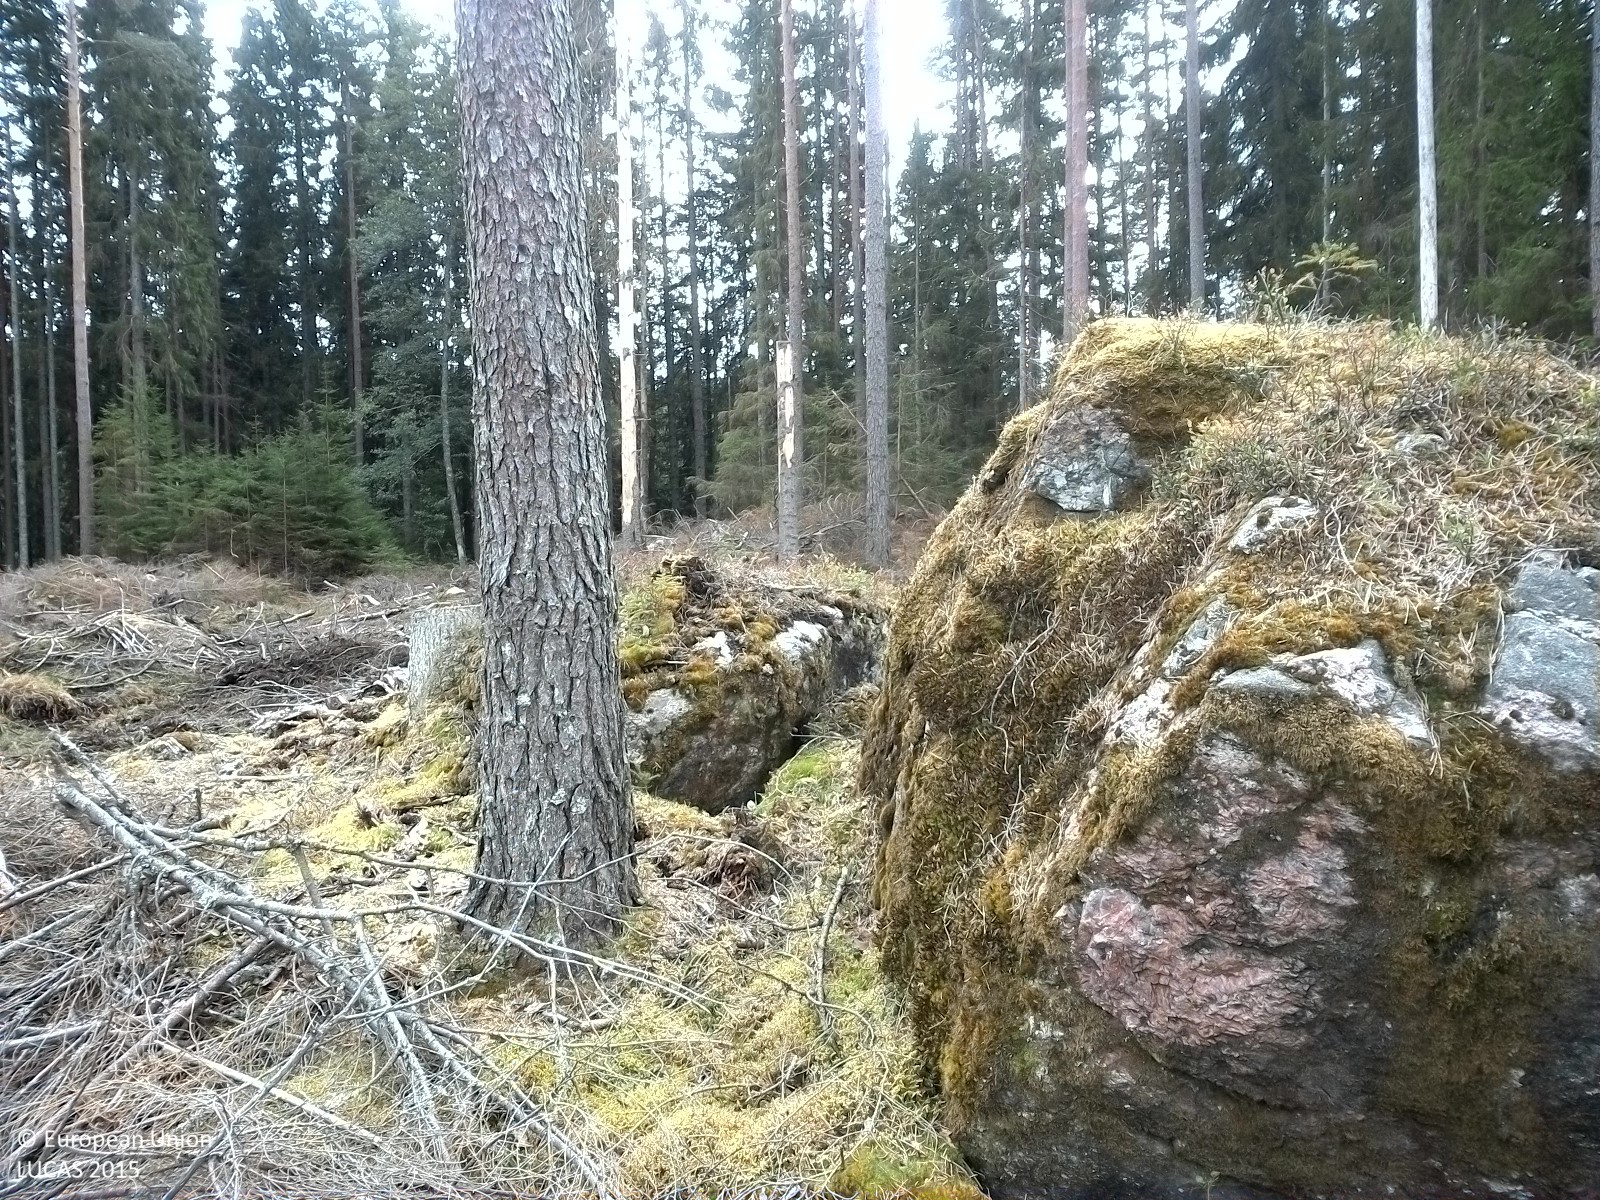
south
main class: Grassland
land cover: Spontaneously vegetated surfaces
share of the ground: 50 - 75 %
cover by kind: herbaceous plants 55 %, lichens and mosses 25 %, unconsolidated bare surface 20 %
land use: Forestry
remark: Clear cut
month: August
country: SE
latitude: 58.9904
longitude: 15.5093
